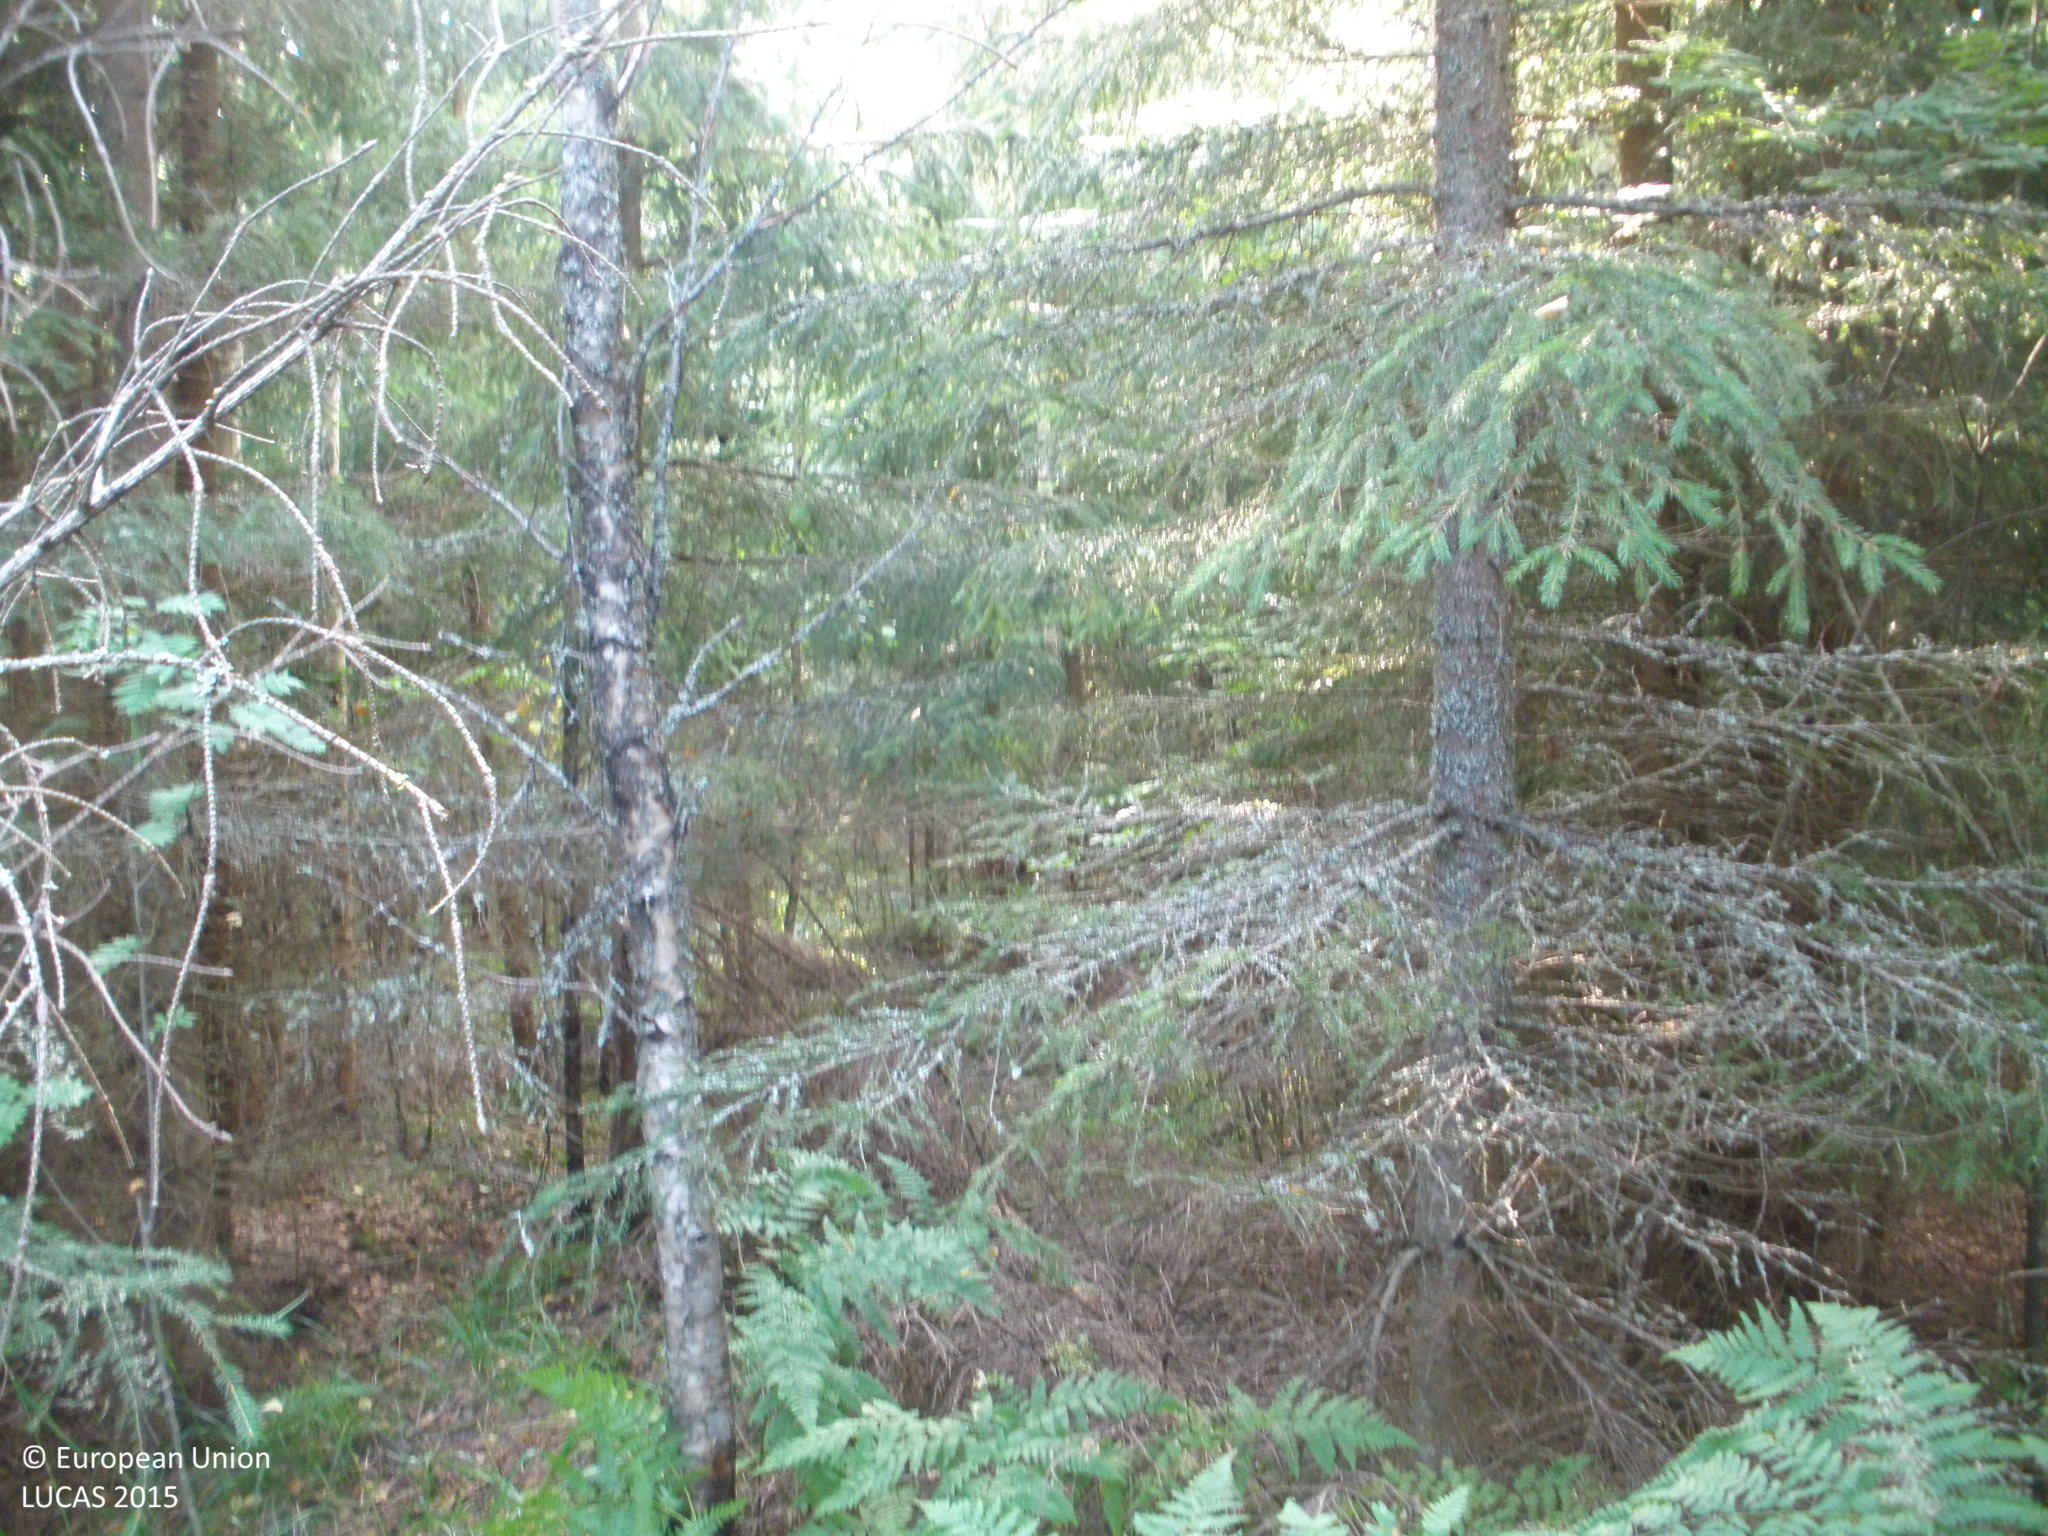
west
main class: Woodland
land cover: Spruce dominated mixed woodland
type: boreal forest
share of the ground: > 75 %
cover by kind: coniferous forest trees 60 %, broadleaved forest trees 25 %, herbaceous plants 10 %, lichens and mosses 5 %
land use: Forestry
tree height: > 5 m
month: August
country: FI
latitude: 60.7050
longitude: 24.3744
